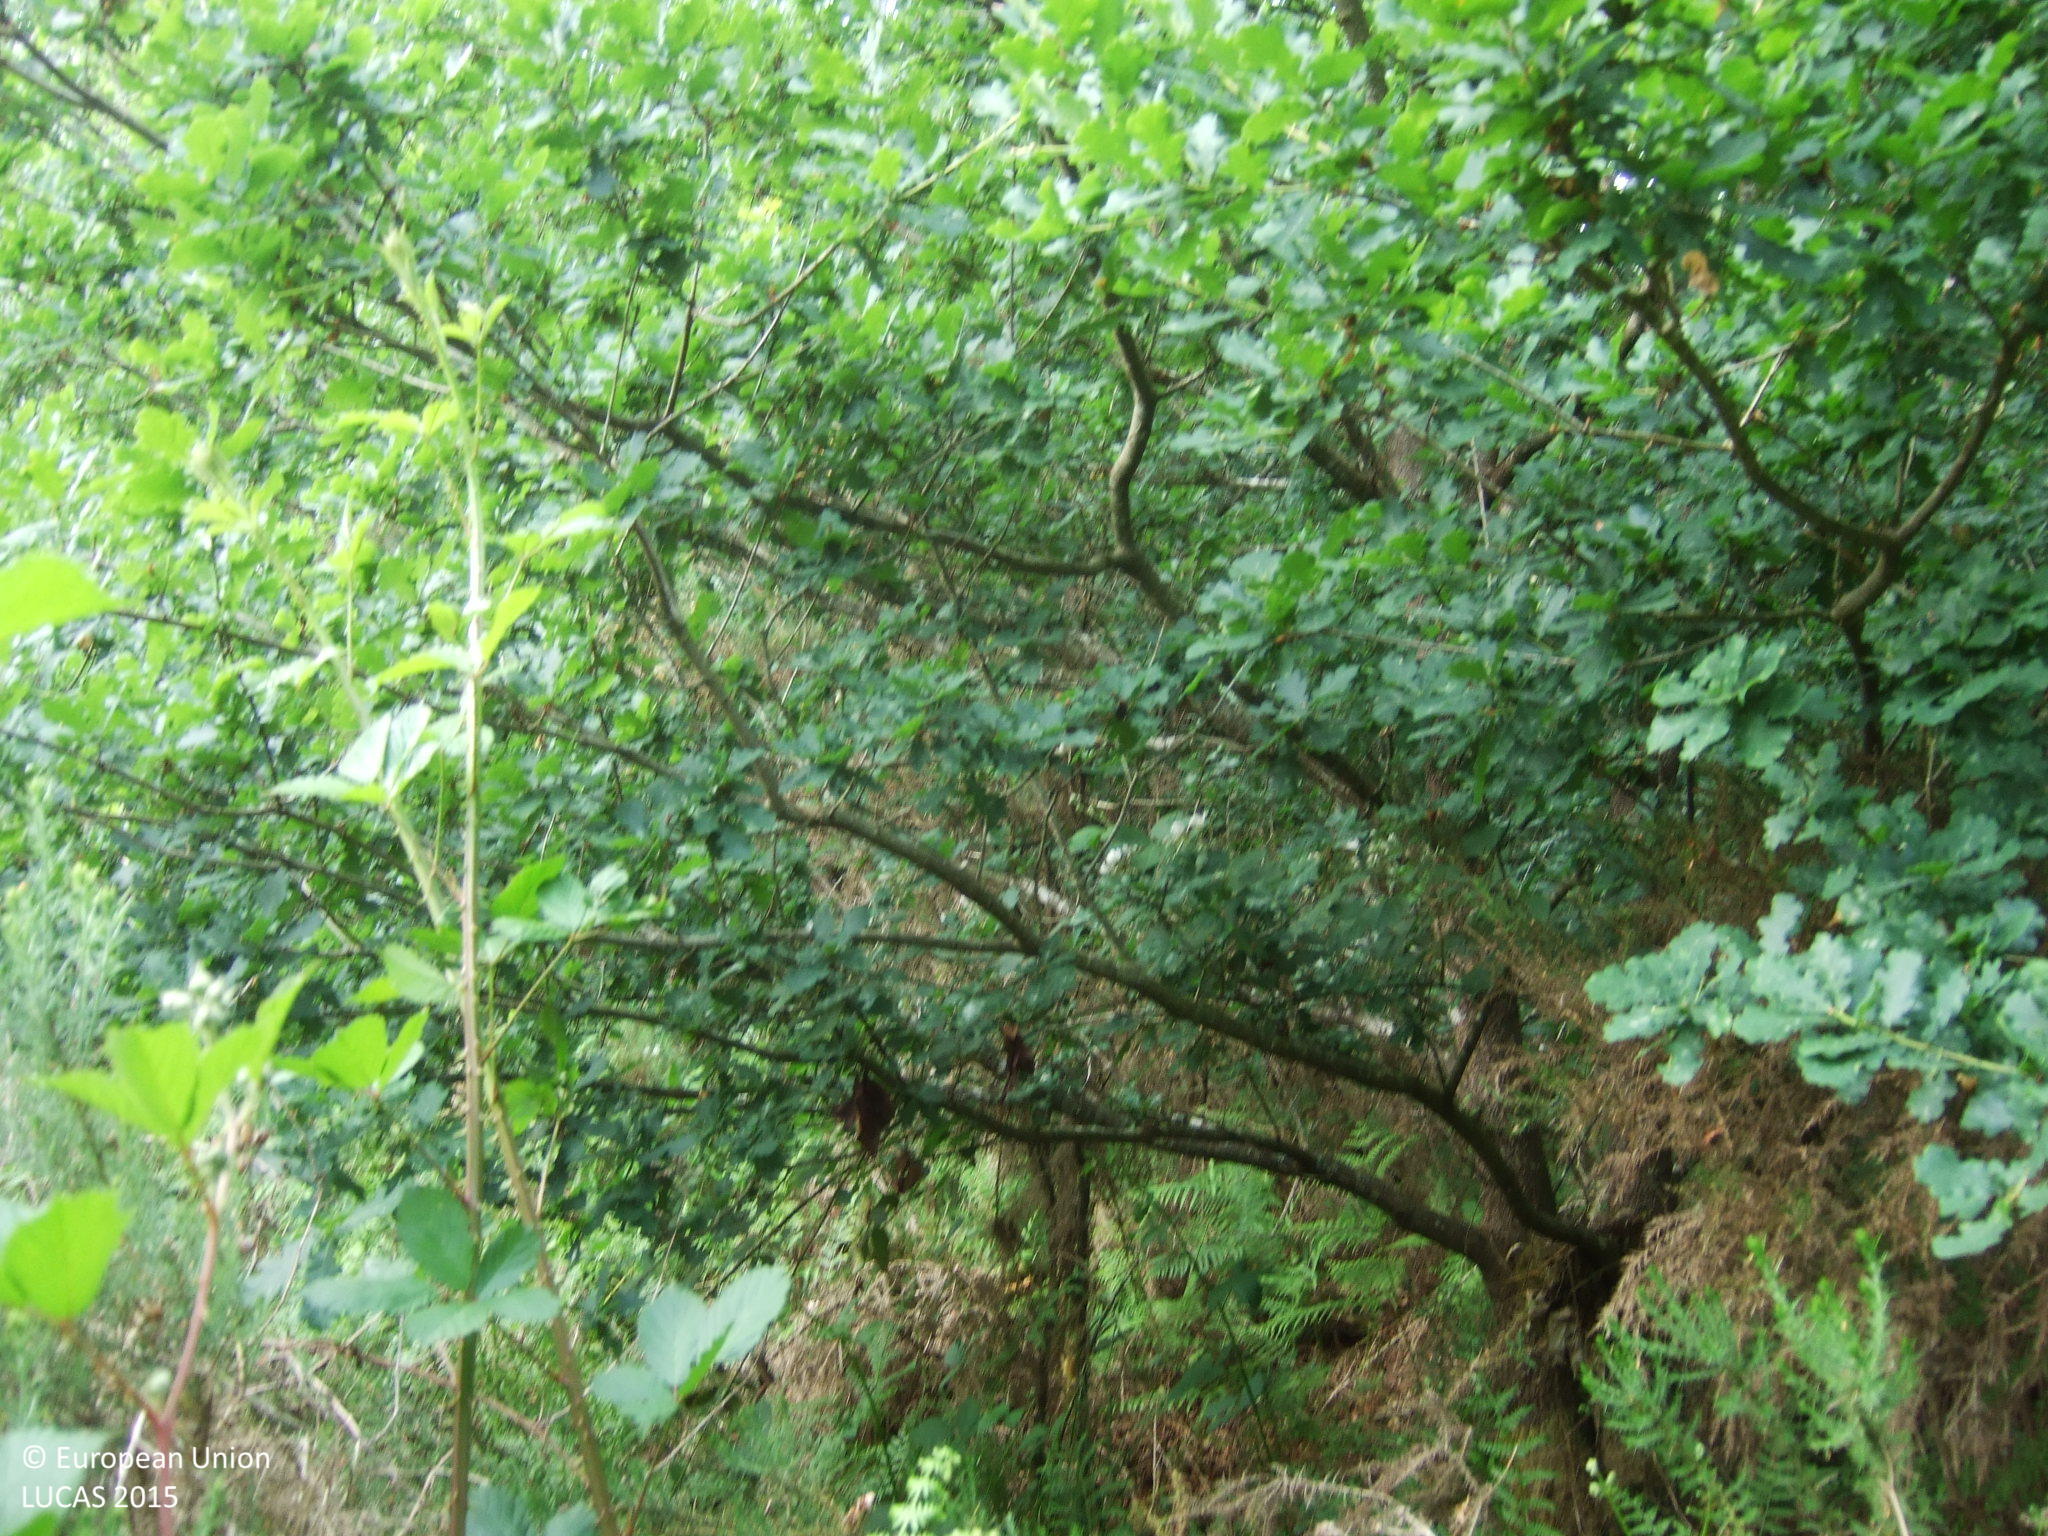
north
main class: Woodland
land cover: Broadleaved woodland
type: acidophilous oak and oak-birch forest
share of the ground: 50 - 75 %
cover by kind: broadleaved forest trees 50 %, shrubs 45 %
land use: Abandoned areas
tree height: < 5 m
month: June
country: ES
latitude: 43.2936
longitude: -7.6980
